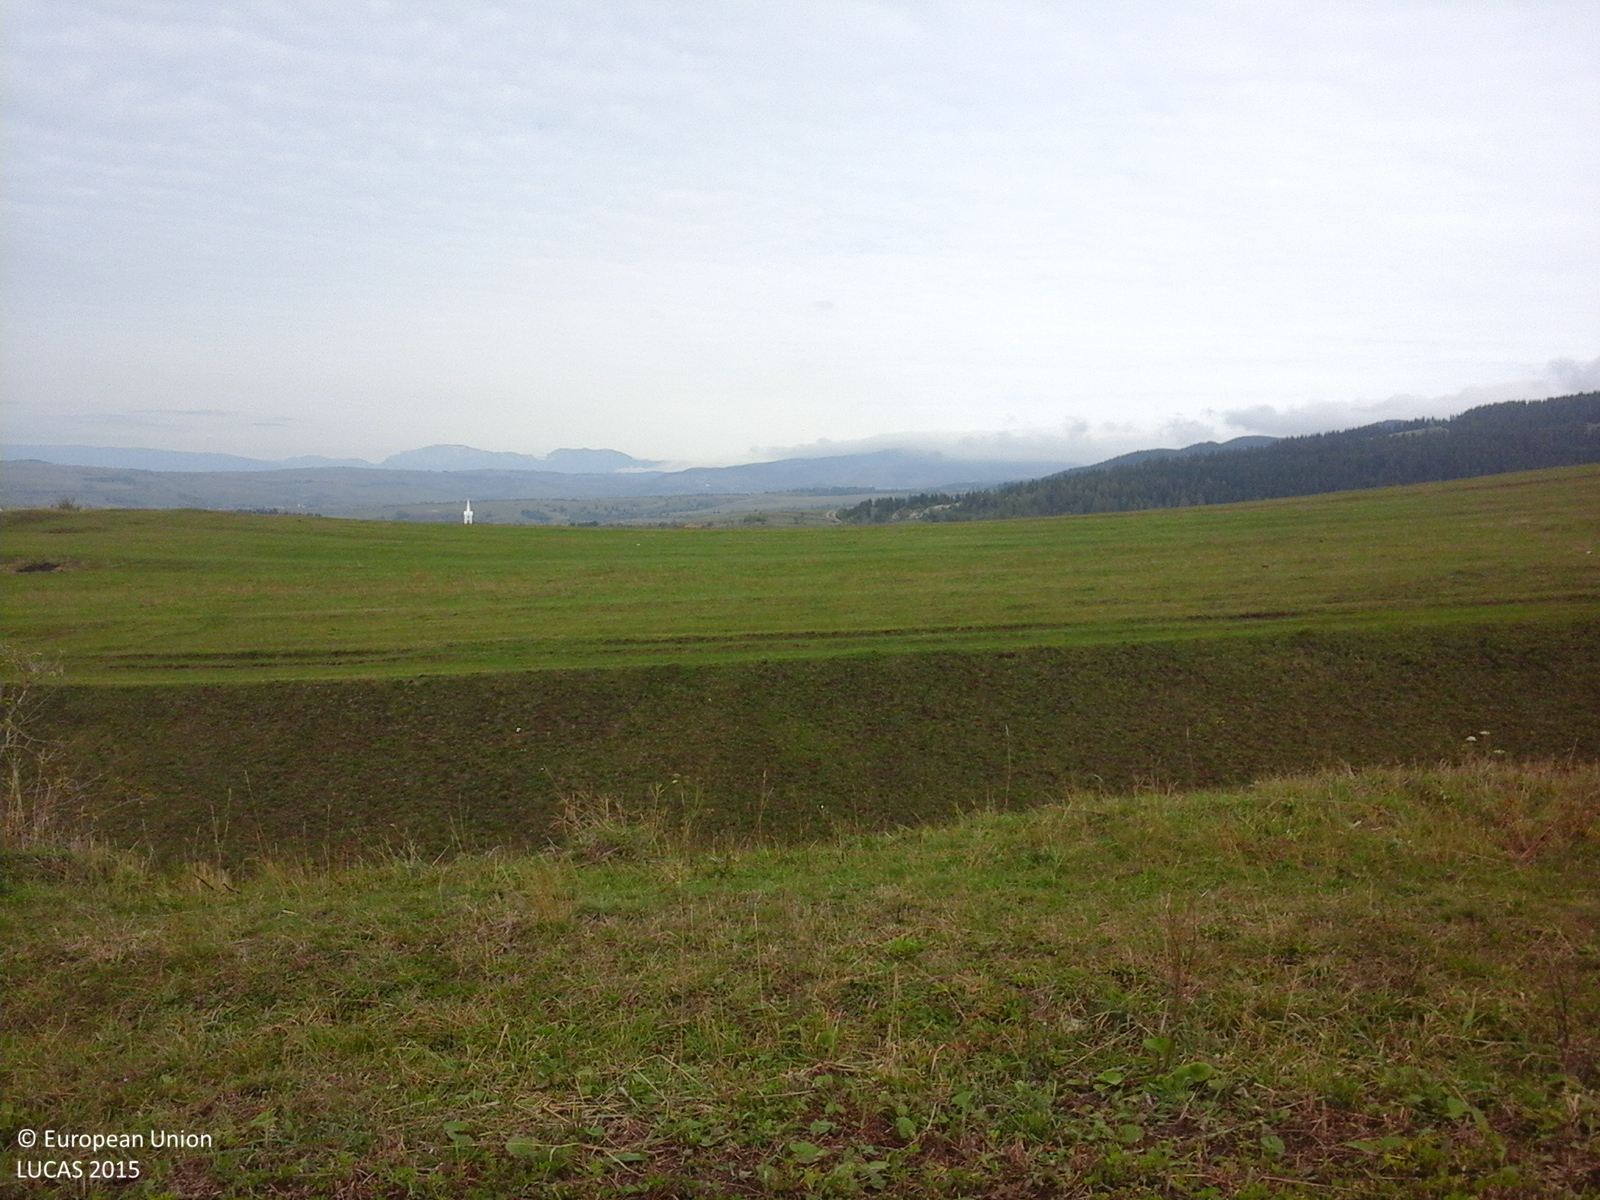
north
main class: Cropland
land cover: Lucerne
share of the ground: > 75 %
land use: Agriculture (excluding fallow land and kitchen gardens)
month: October
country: RO
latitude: 46.4431
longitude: 25.8542
